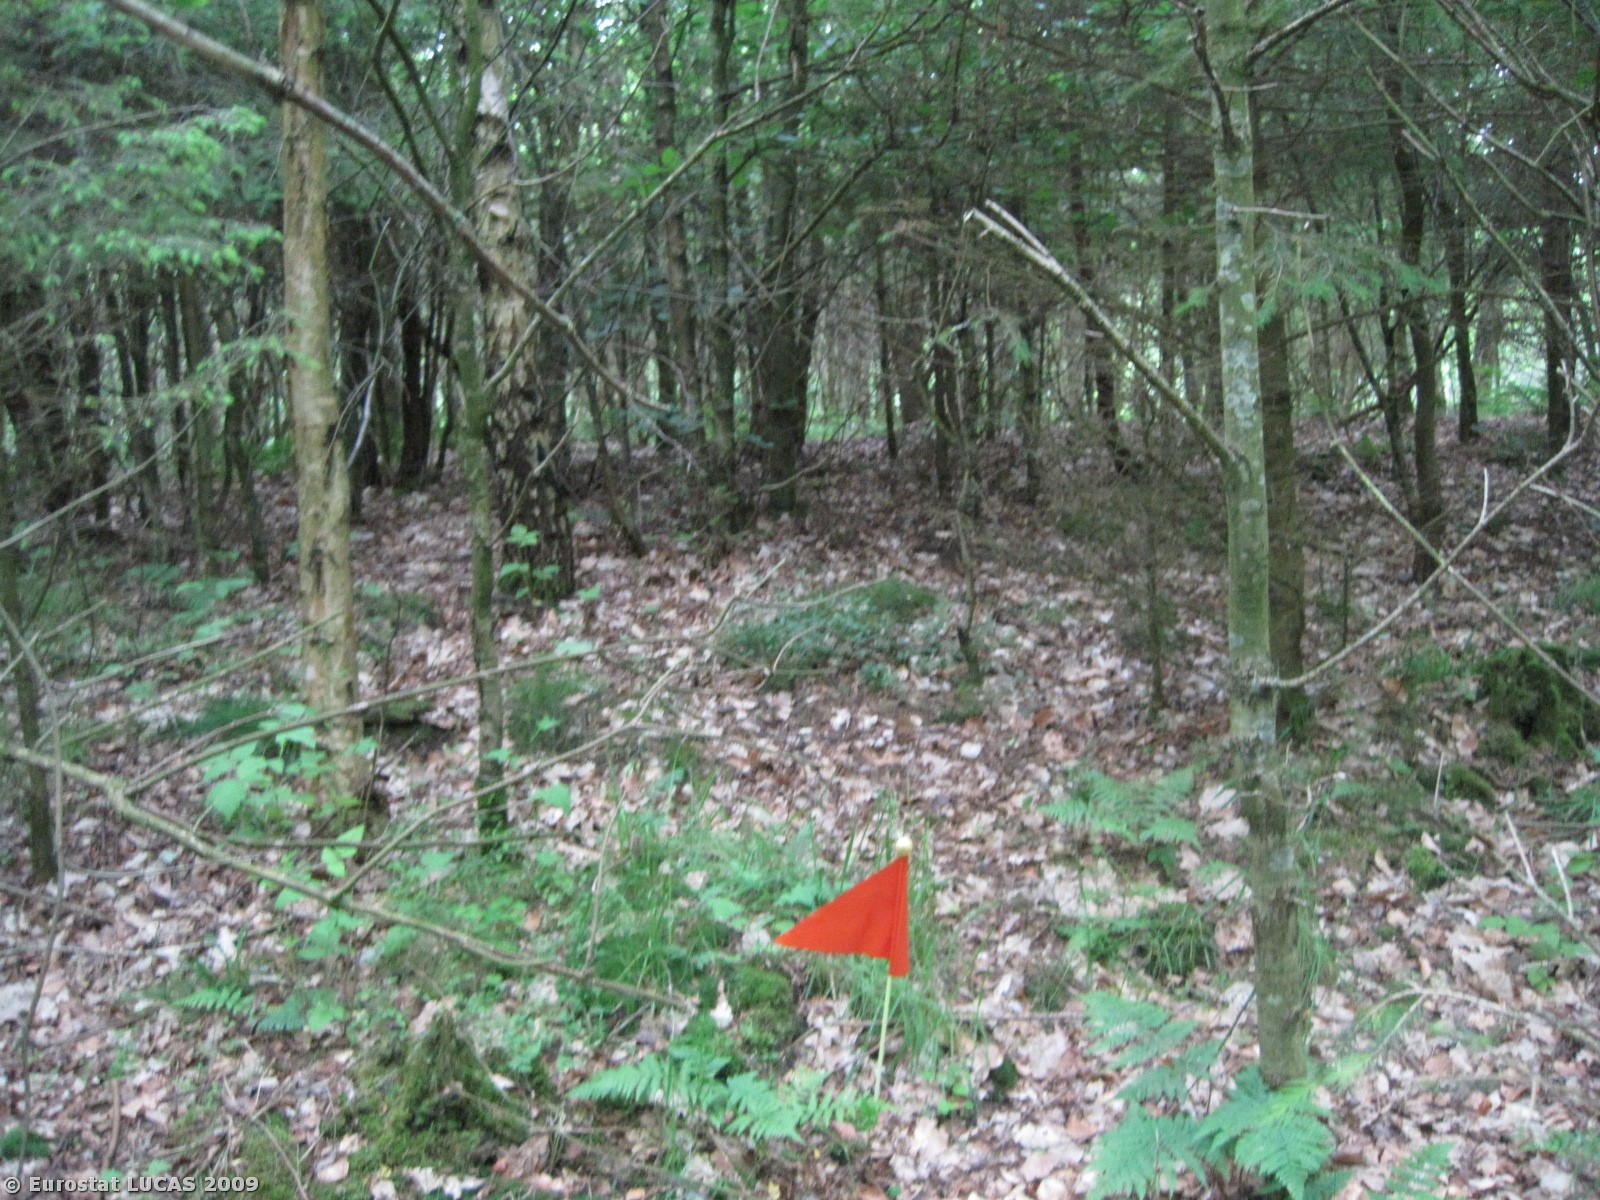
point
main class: Woodland
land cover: Mixed woodland
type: hemiboreal forest and nemoral coniferous forest and mixed broadleaved-coniferous forest
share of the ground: > 75 %
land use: Forestry
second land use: Amenities, museums, leisure
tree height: > 5 m
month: June
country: DK
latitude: 57.1225
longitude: 10.0165
